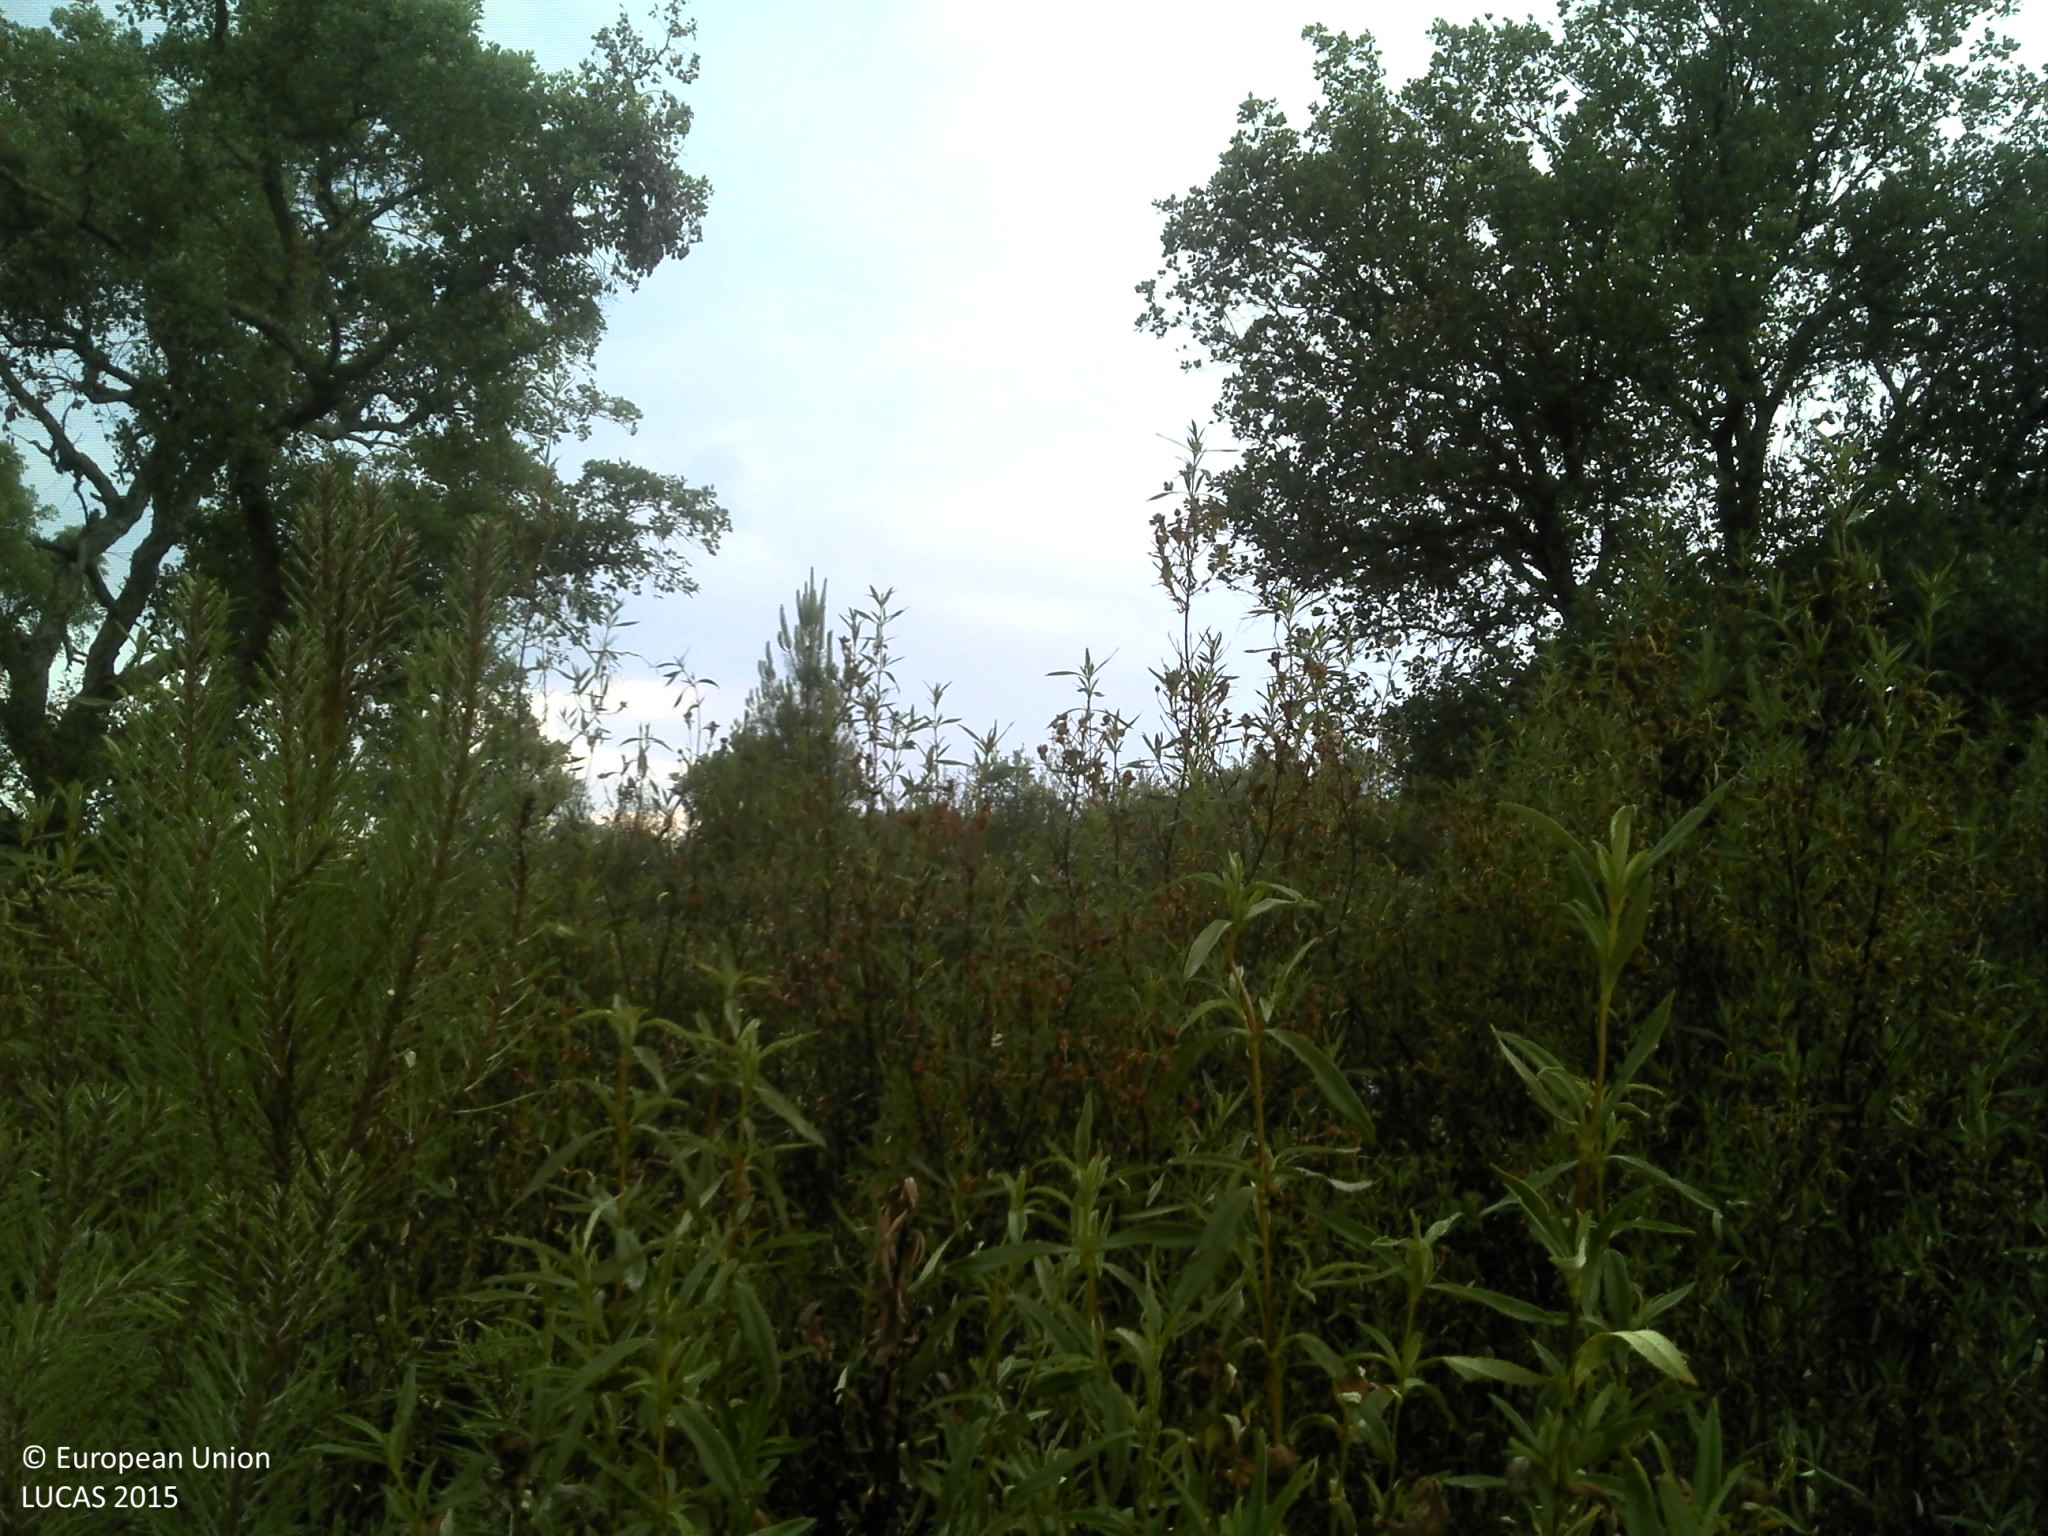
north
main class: Woodland
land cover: Broadleaved woodland
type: broadleaved evergreen forest
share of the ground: 10 - 25 %
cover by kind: shrubs 50 %, broadleaved forest trees 25 %, unconsolidated bare surface 15 %, herbaceous plants 10 %
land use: Forestry
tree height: > 5 m
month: June
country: PT
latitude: 39.3702
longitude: -8.0615
